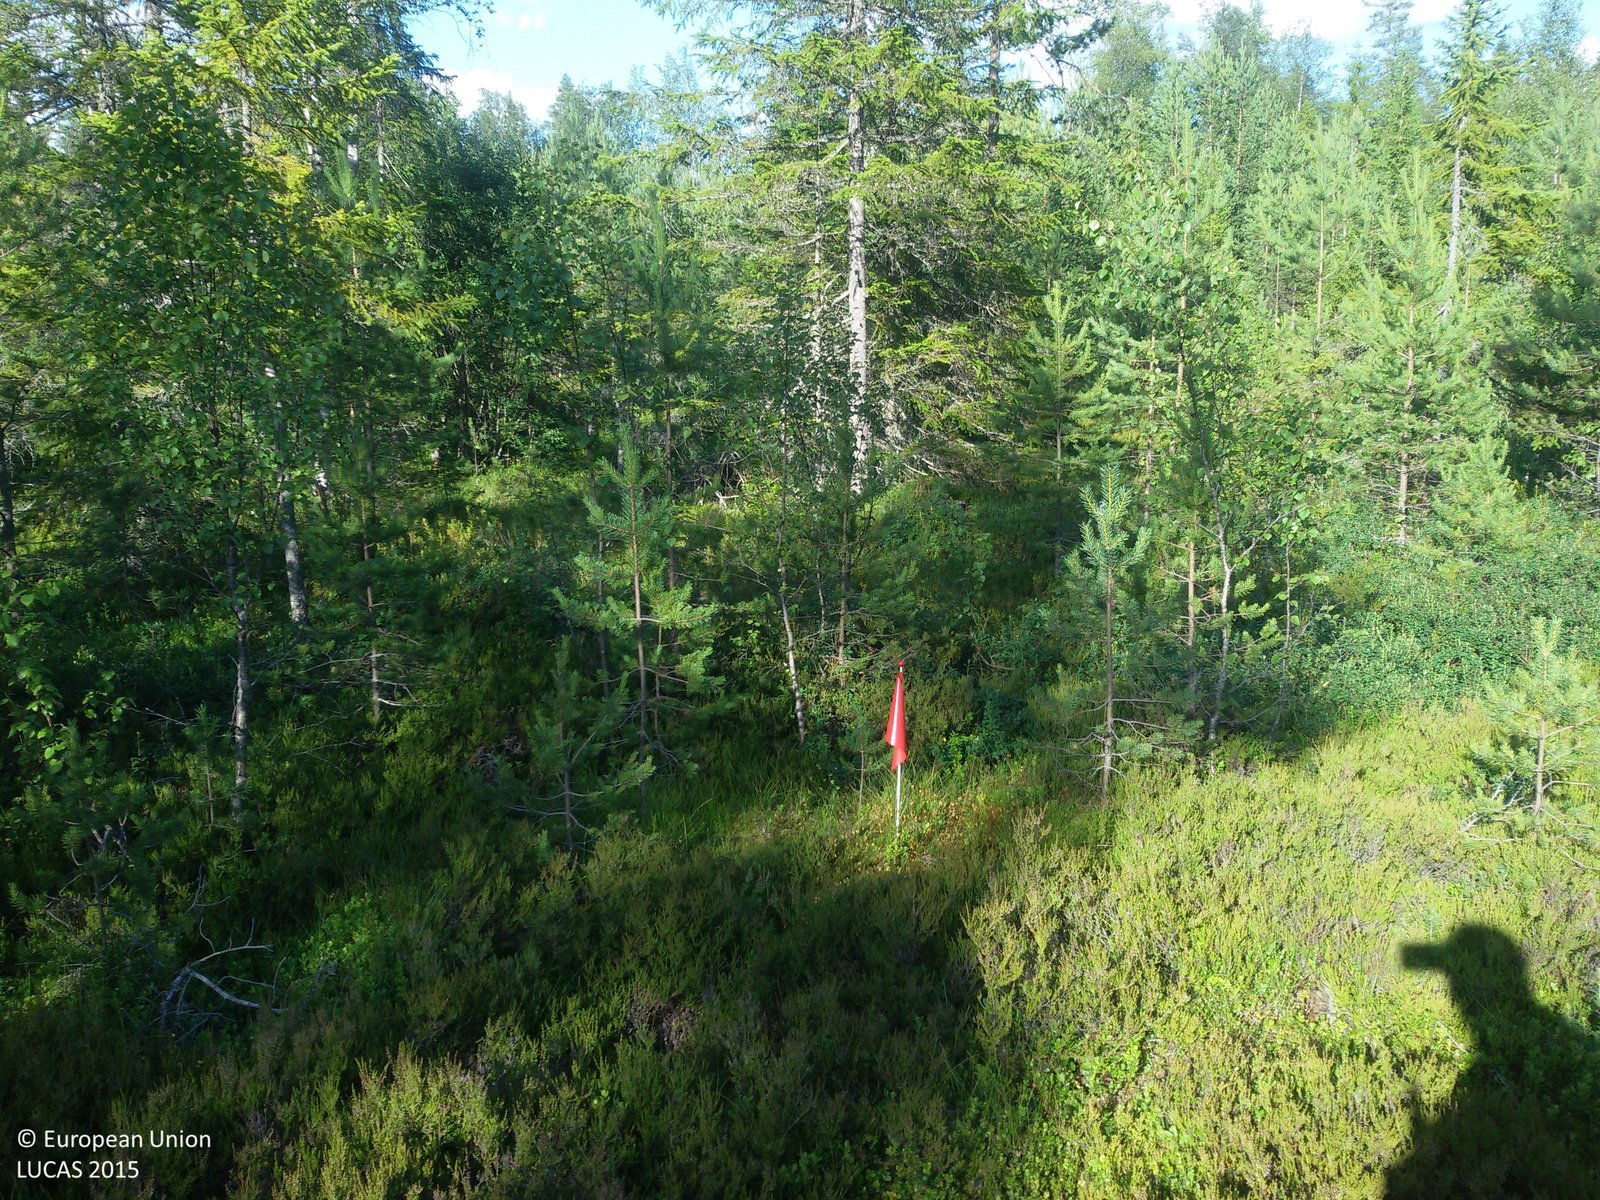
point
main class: Woodland
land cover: Pine dominated coniferous woodland
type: boreal forest
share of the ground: 50 - 75 %
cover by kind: coniferous forest trees 50 %, herbaceous plants 50 %
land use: Forestry
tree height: > 5 m
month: July
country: SE
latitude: 60.6762
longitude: 15.3138
